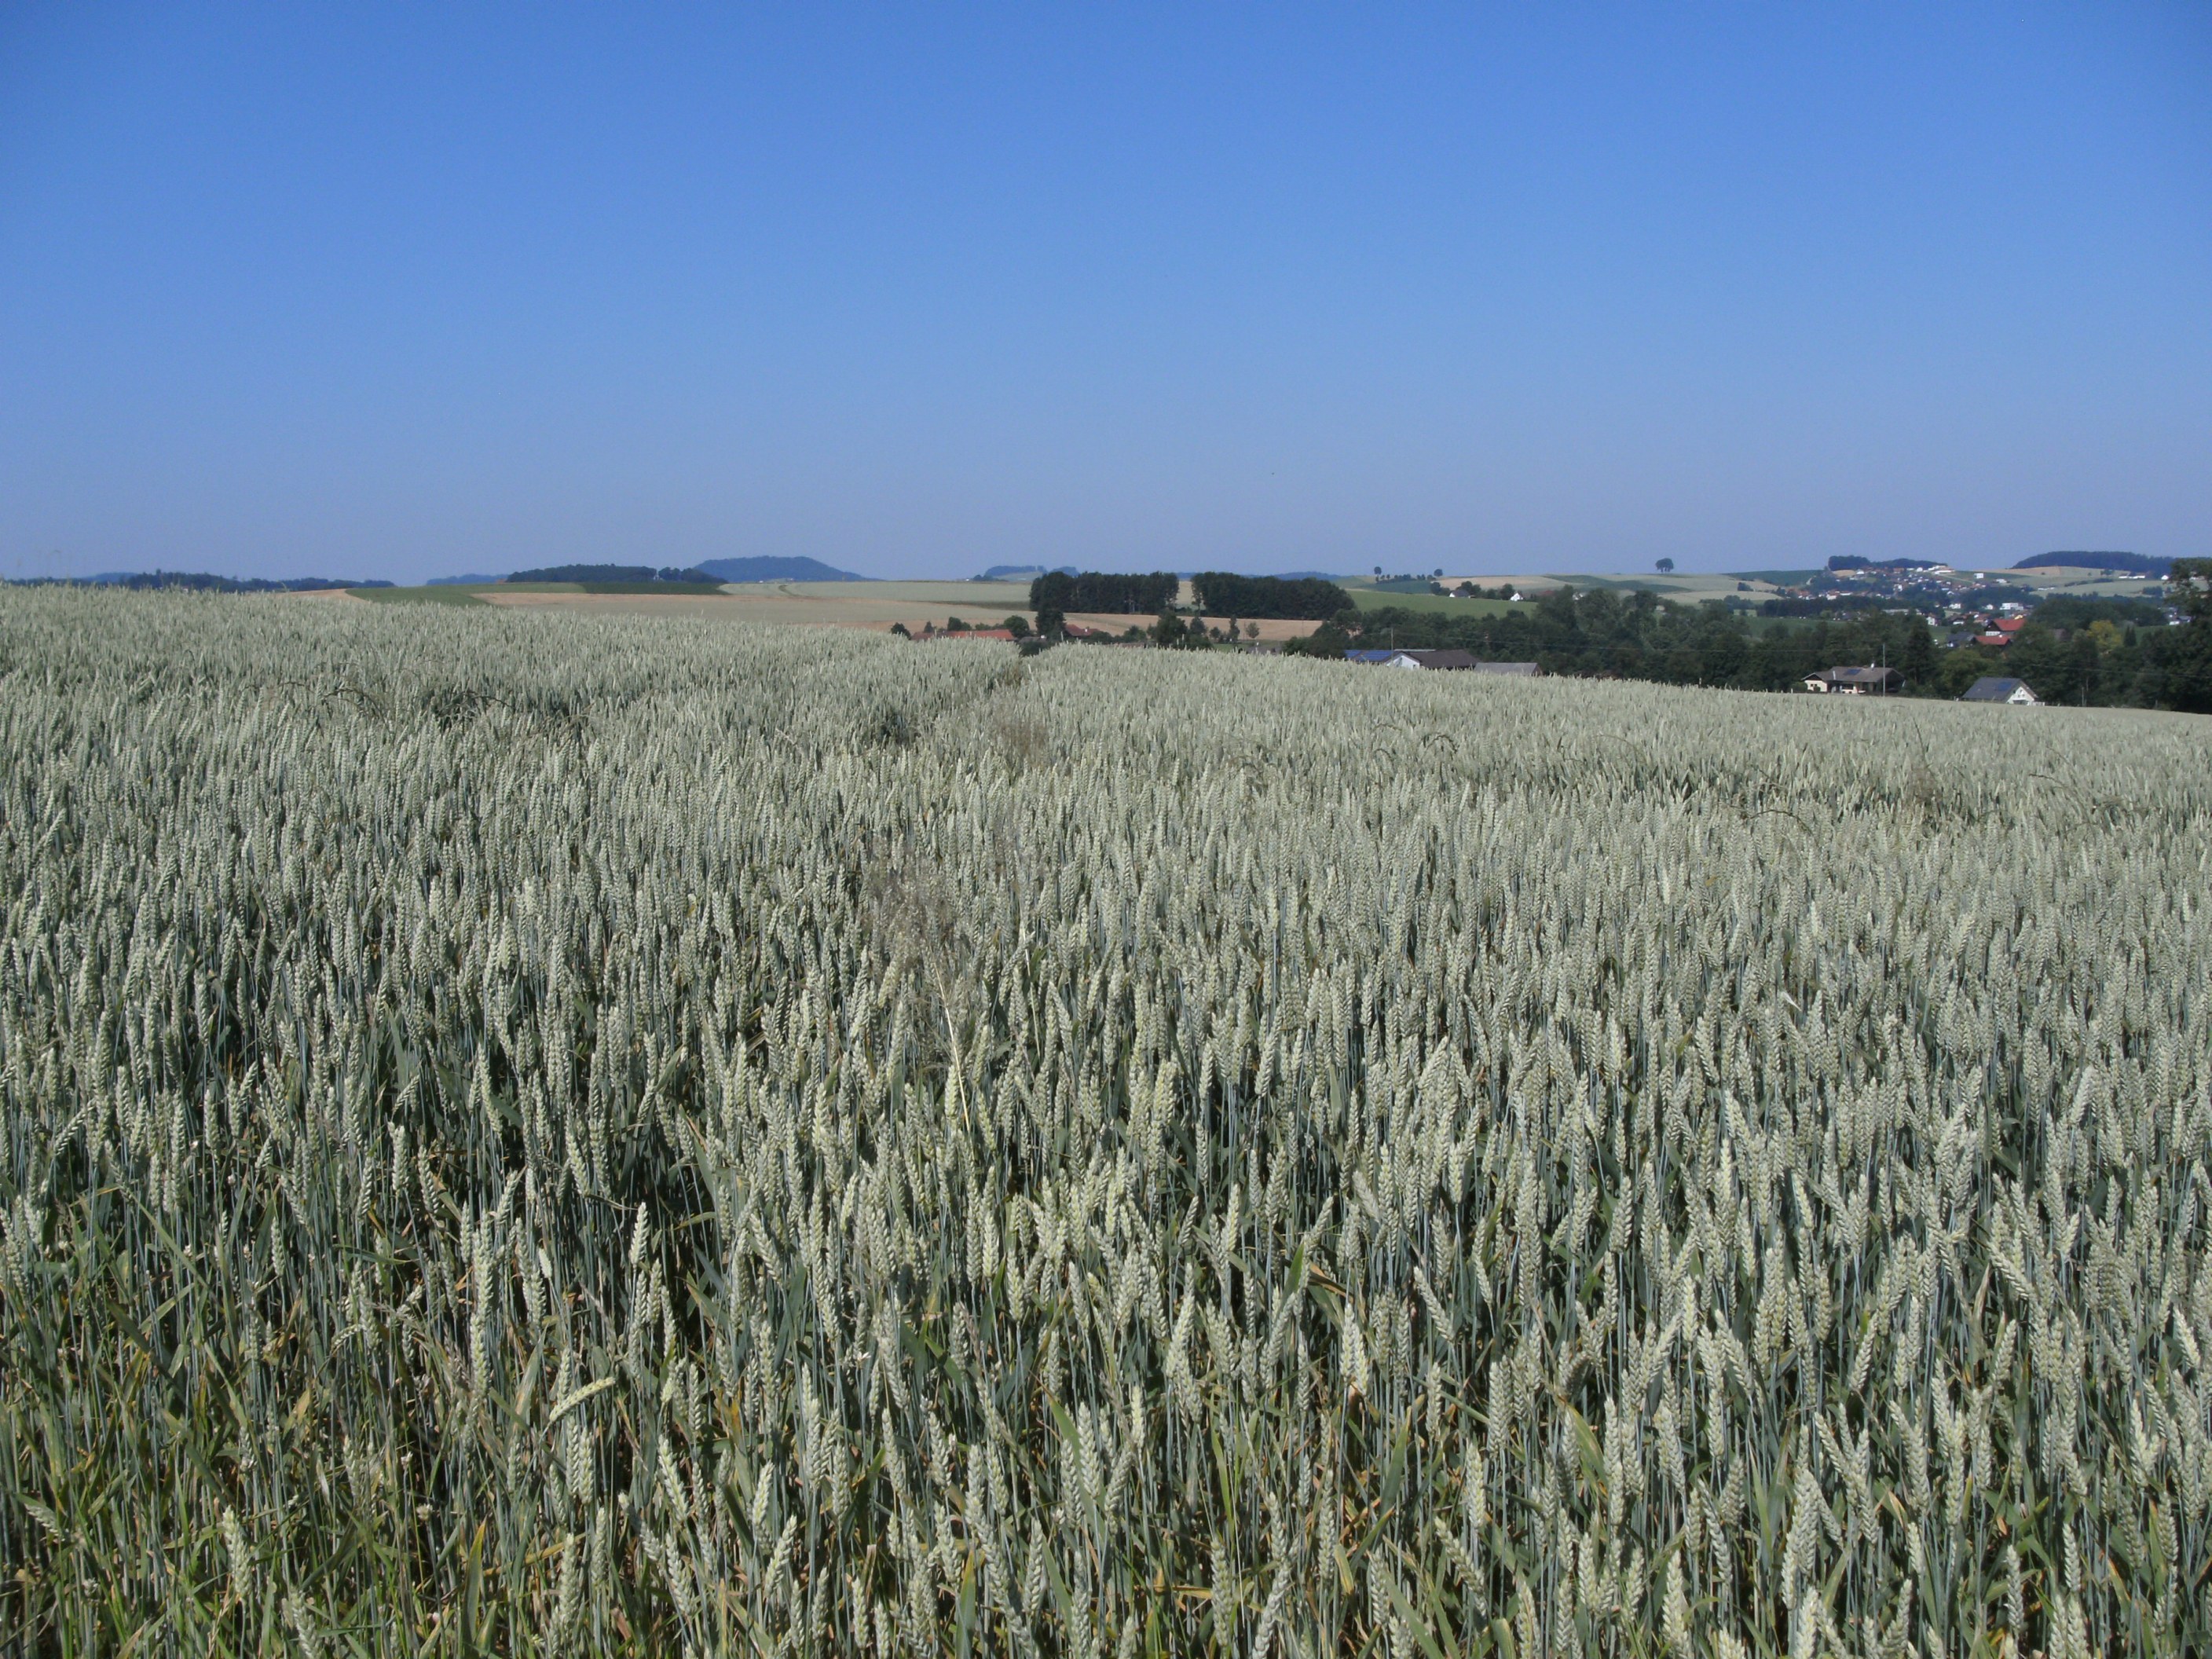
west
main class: Cropland
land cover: Common wheat
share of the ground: > 75 %
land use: Agriculture (excluding fallow land and kitchen gardens)
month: July
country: AT
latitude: 48.1318
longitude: 13.5062
